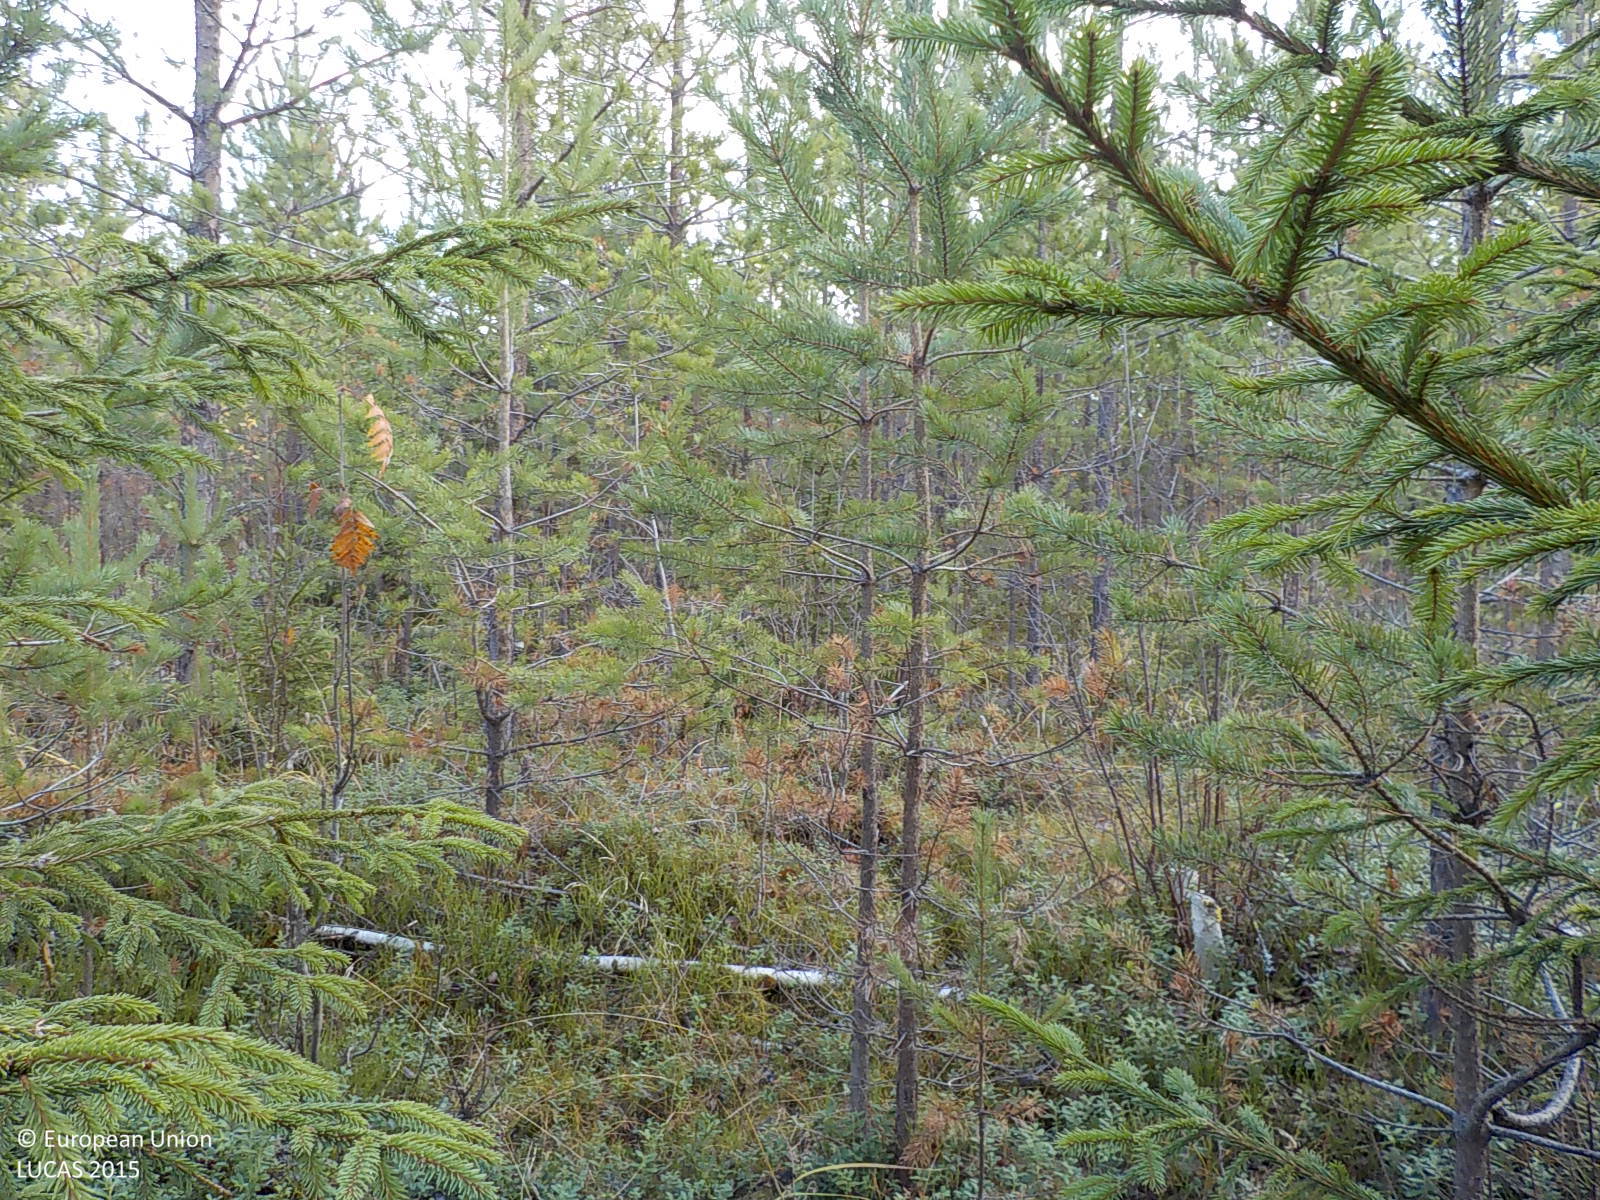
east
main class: Woodland
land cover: Pine dominated coniferous woodland
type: boreal forest
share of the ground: > 75 %
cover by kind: coniferous forest trees 85 %, shrubs 10 %, herbaceous plants 5 %
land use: Forestry
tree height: > 5 m
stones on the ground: < 10 %
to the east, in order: Pine dominated coniferous woodland; Tracks; Pine dominated coniferous woodland; Broadleaved woodland; Spruce dominated coniferous woodland
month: October
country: SE
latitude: 63.3379
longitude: 16.9858
